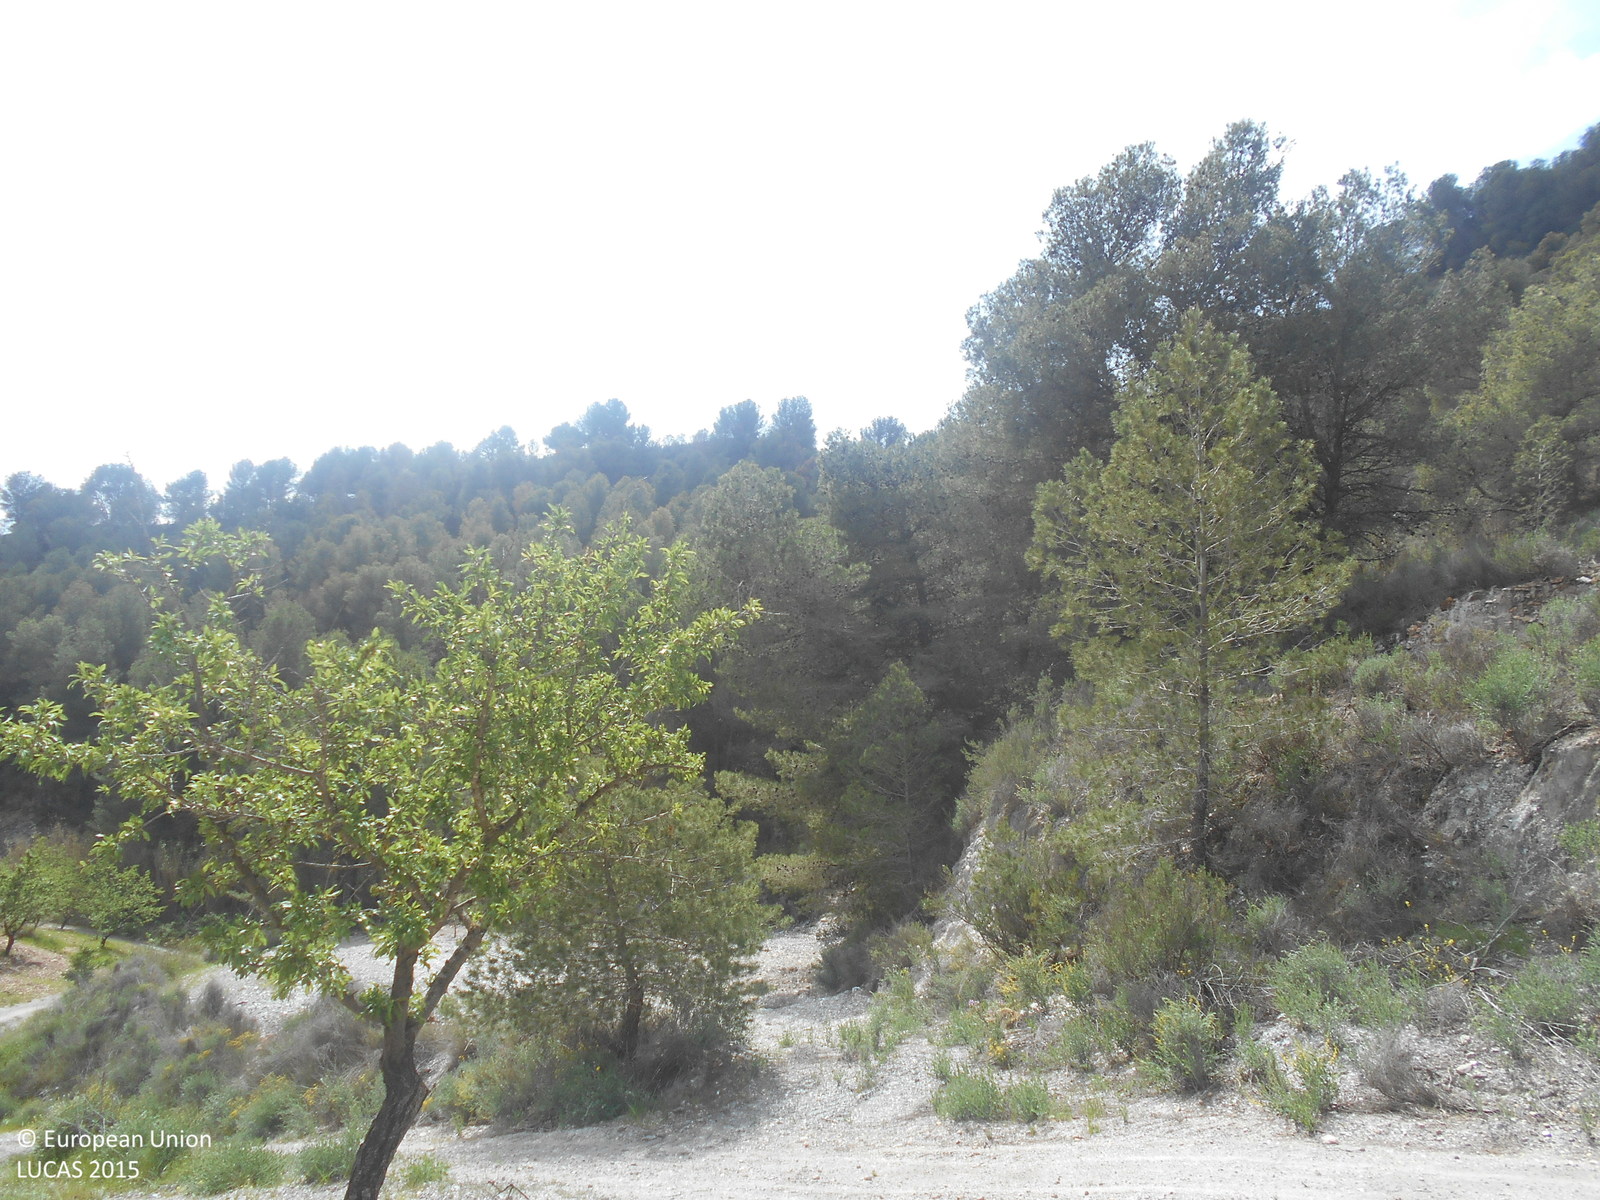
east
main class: Woodland
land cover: Pine dominated coniferous woodland
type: coniferous forest of the mediterranean region
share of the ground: > 75 %
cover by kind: coniferous forest trees 50 %, shrubs 40 %, unconsolidated bare surface 10 %
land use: Semi-natural and natural areas not in use
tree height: > 5 m
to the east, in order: Pine dominated coniferous woodland
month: April
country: ES
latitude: 37.6296
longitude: -1.5276
